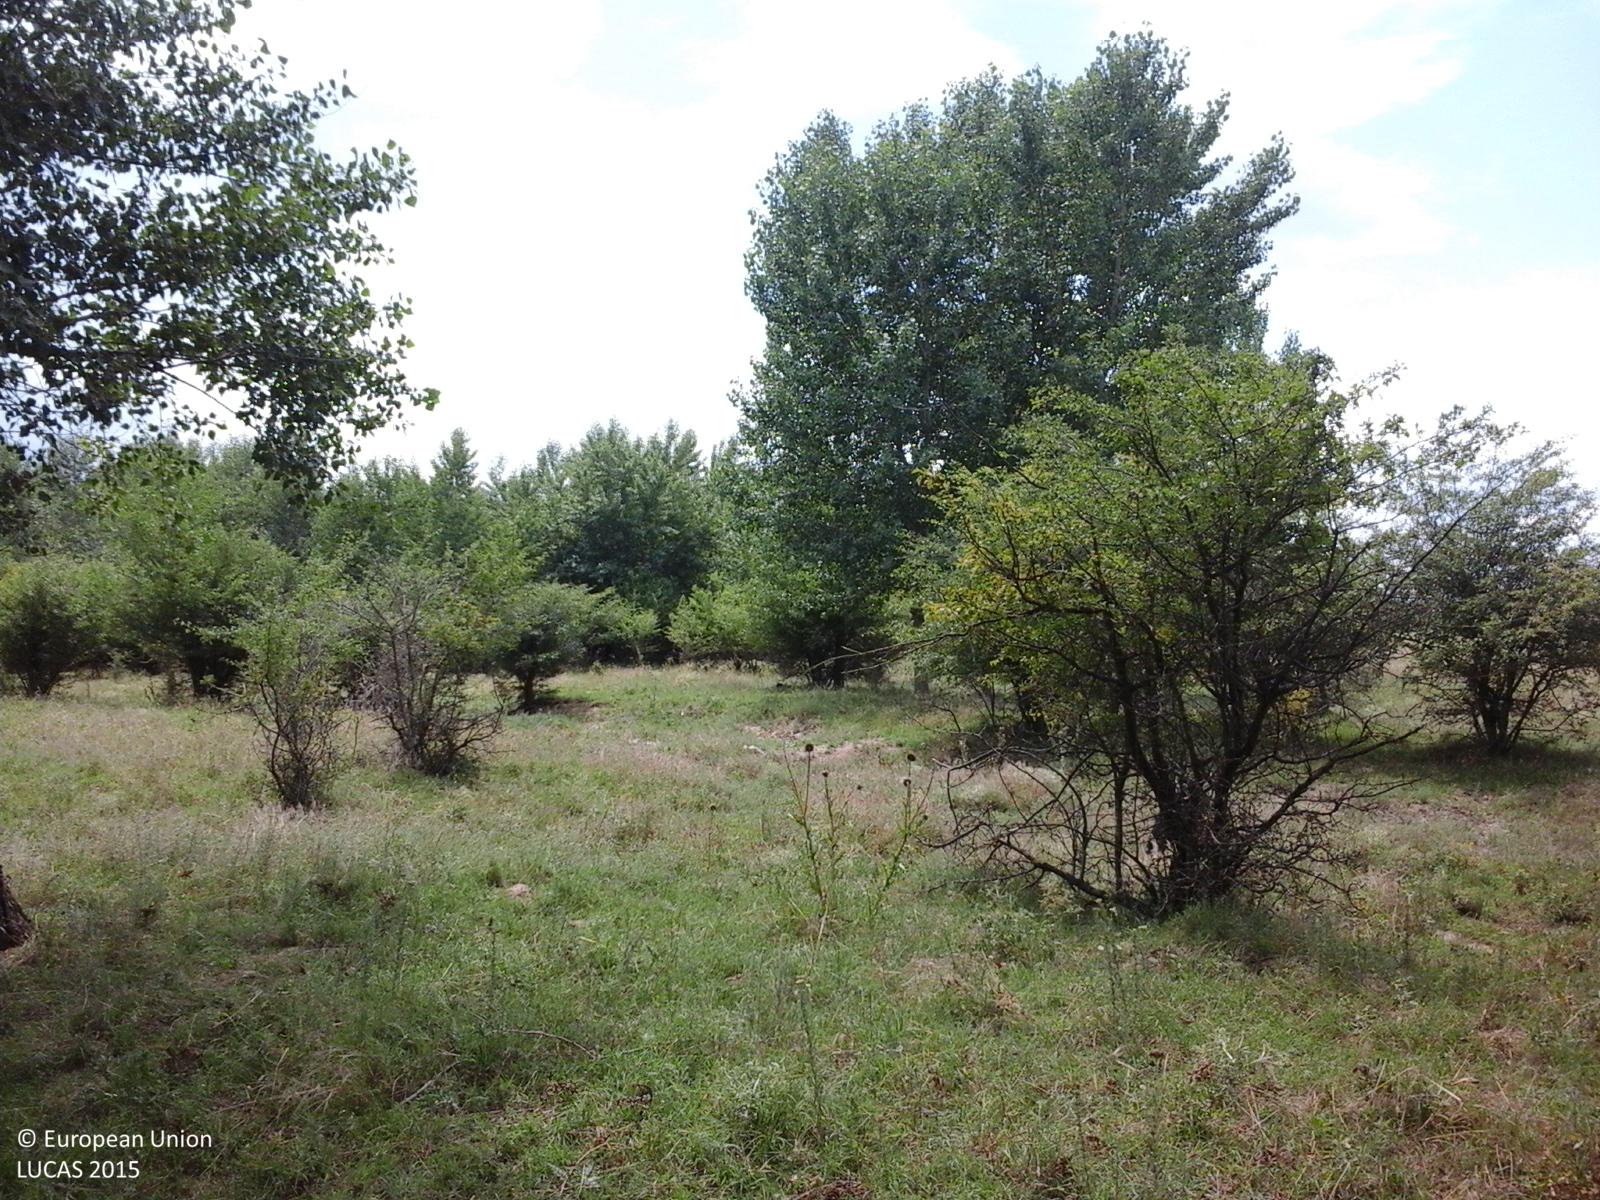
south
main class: Woodland
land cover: Broadleaved woodland
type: non-riverine alder, birch or aspen forest
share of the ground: 50 - 75 %
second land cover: Grassland without tree/shrub cover
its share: > 75 %
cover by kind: broadleaved forest trees 60 %, herbaceous plants 40 %
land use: Forestry
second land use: Agriculture (excluding fallow land and kitchen gardens)
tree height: > 5 m
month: July
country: RO
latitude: 43.9719
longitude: 24.5896
